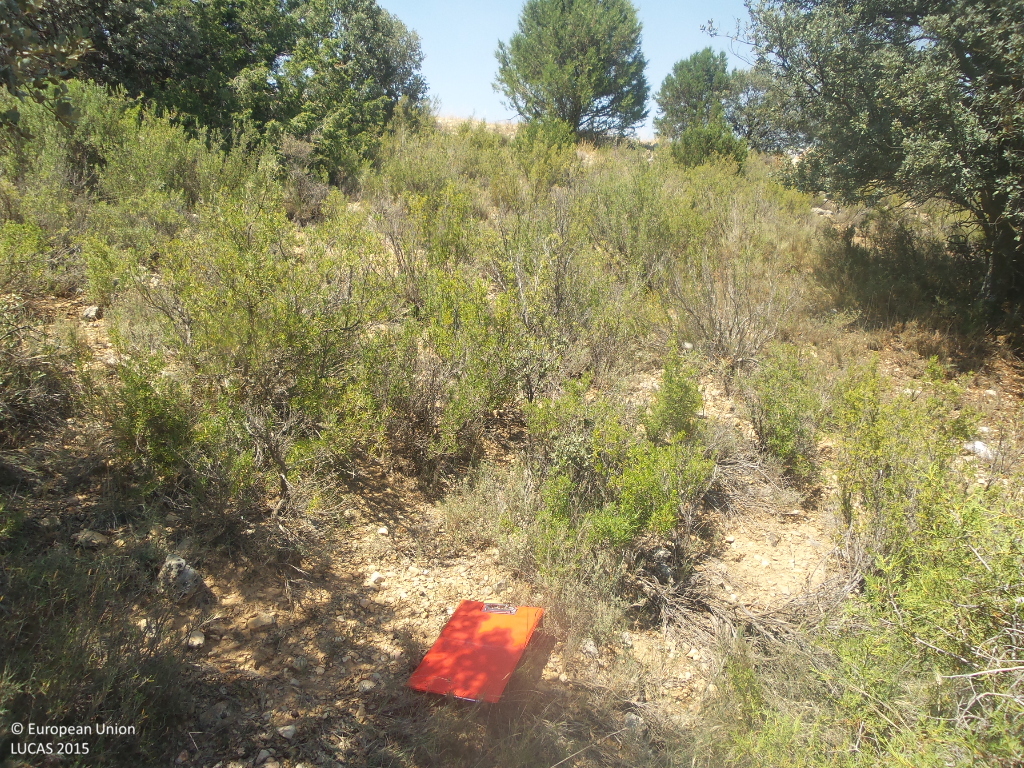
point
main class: Woodland
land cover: Broadleaved woodland
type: broadleaved evergreen forest
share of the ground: 25 - 50 %
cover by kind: broadleaved forest trees 40 %, shrubs 35 %, unconsolidated bare surface 15 %, coniferous forest trees 5 %, herbaceous plants 5 %
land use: Semi-natural and natural areas not in use
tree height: < 5 m
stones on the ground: < 10 %
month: July
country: ES
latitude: 41.1892
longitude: -2.1538
